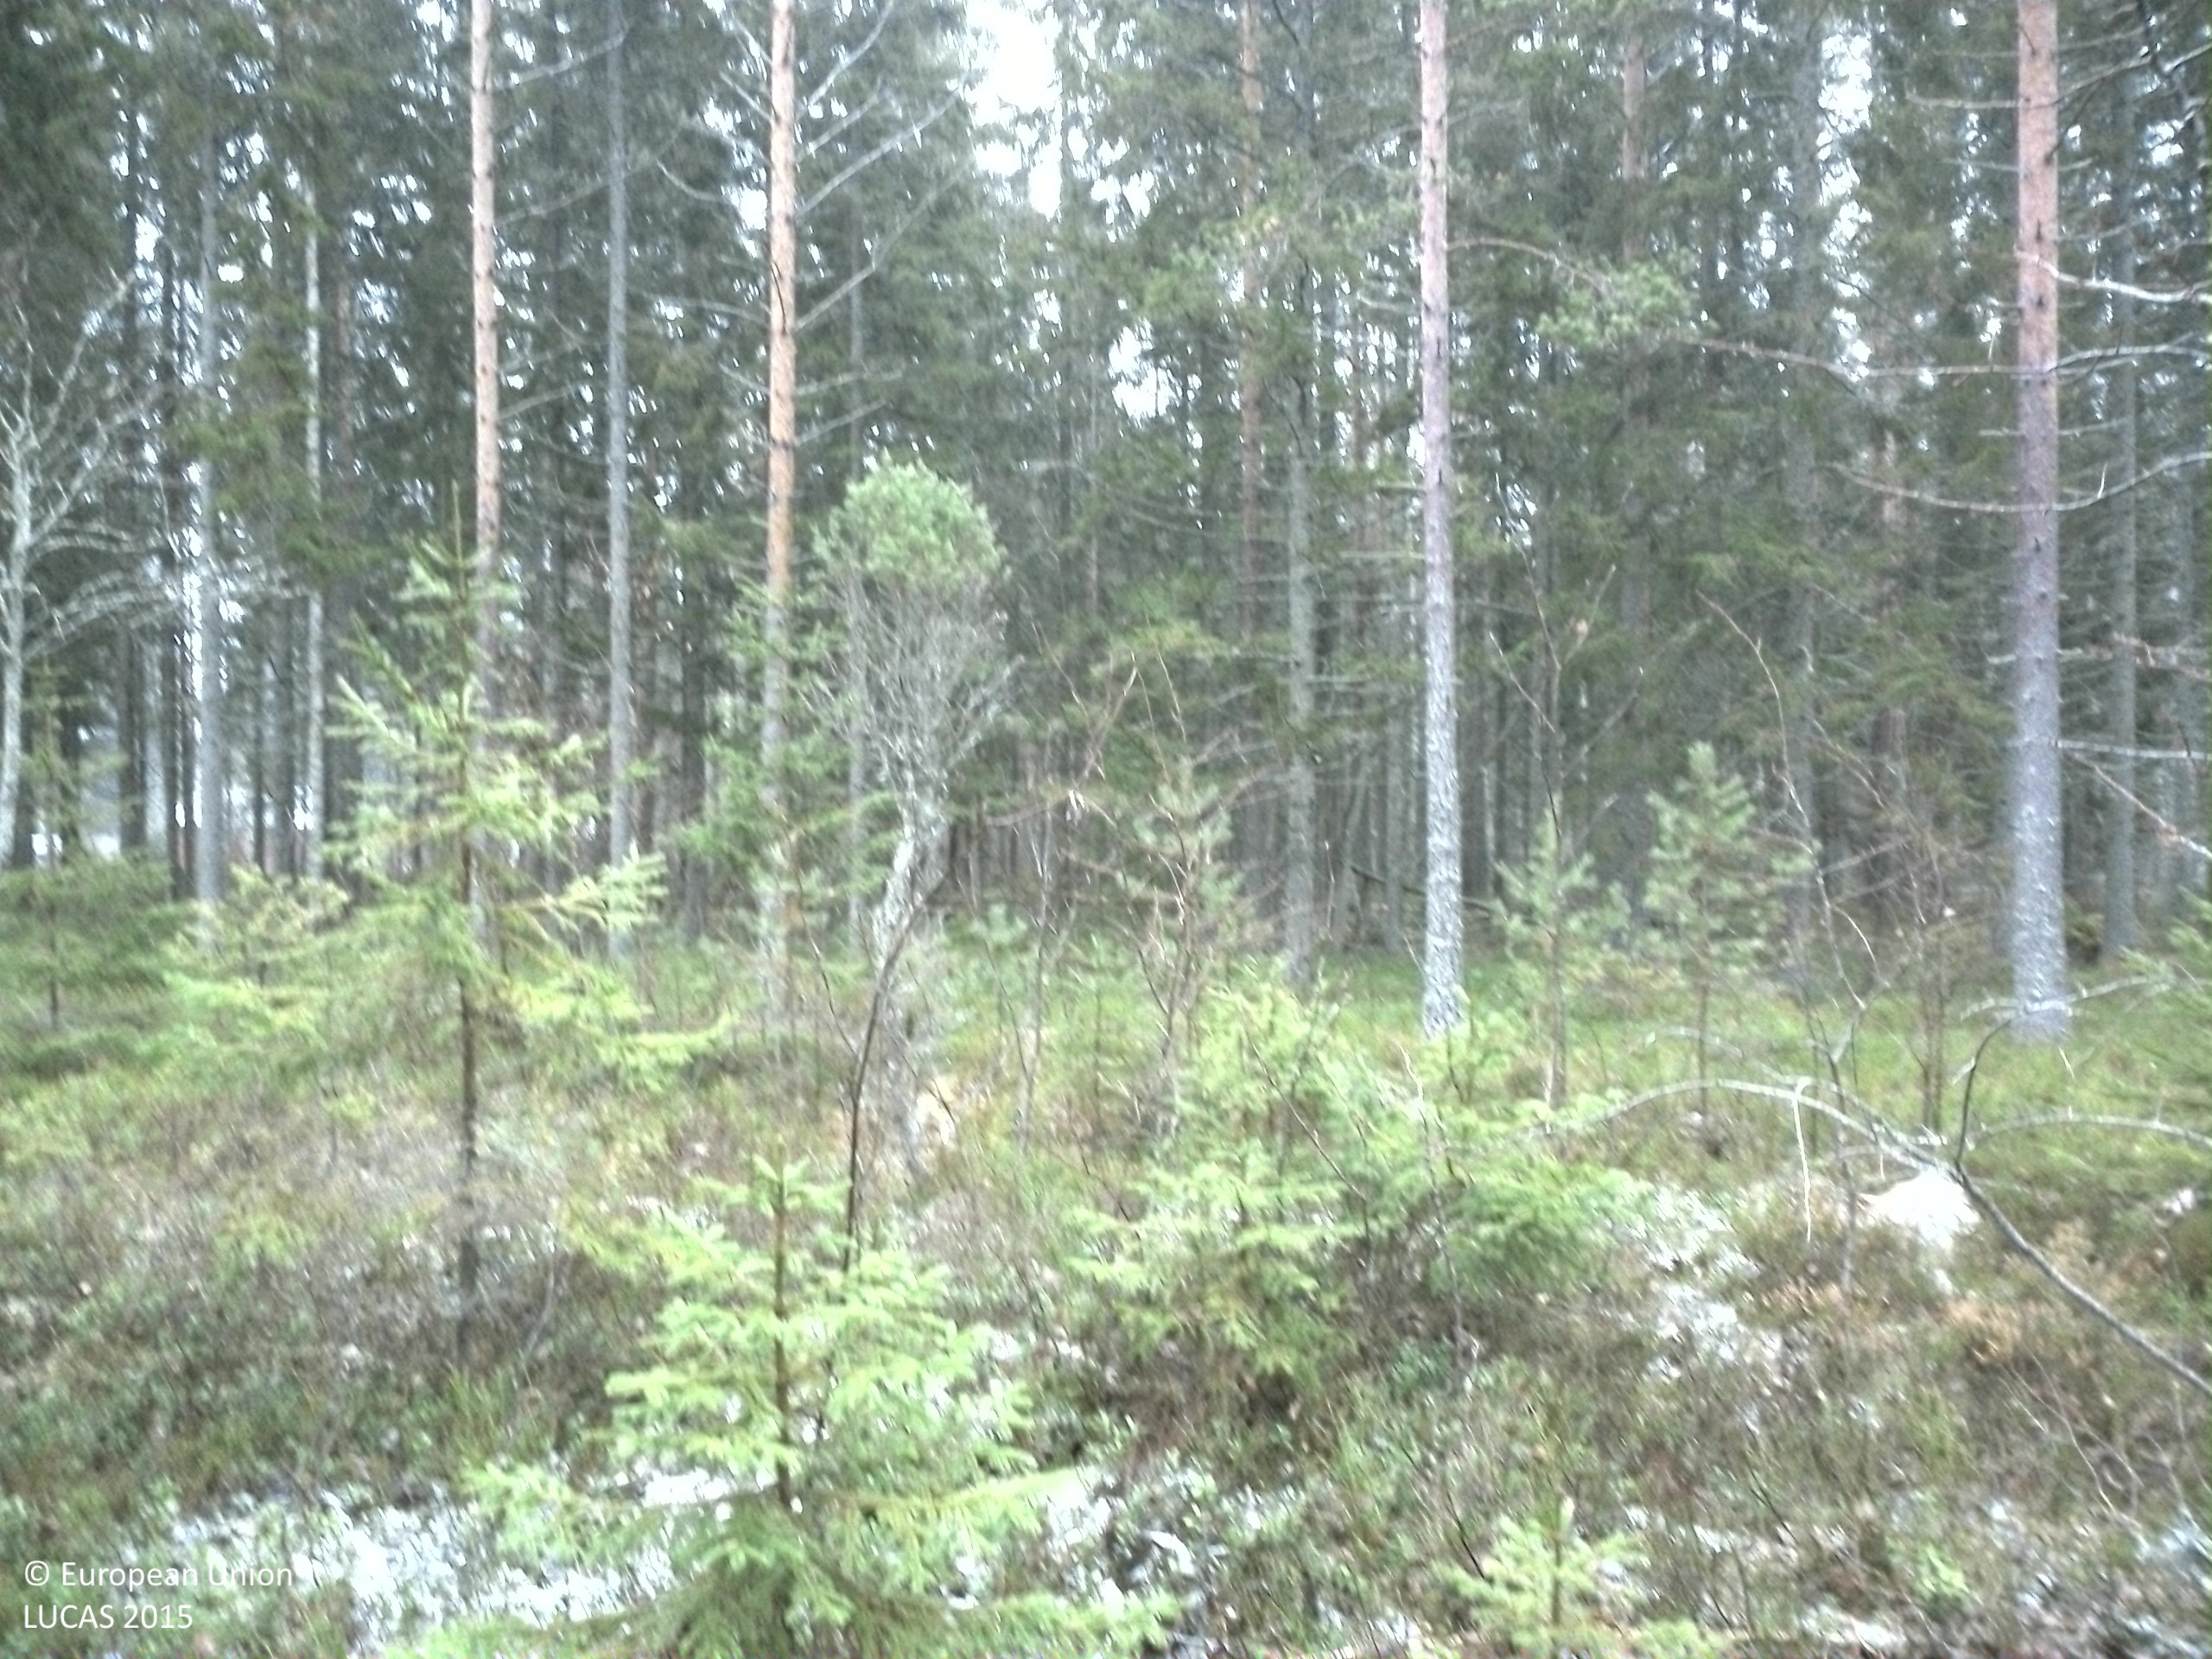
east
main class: Woodland
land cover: Other coniferous woodland
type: boreal forest
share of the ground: 50 - 75 %
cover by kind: coniferous forest trees 60 %, shrubs 25 %, lichens and mosses 10 %, broadleaved forest trees 5 %
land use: Forestry
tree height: > 5 m
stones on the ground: < 10 %
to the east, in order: Other coniferous woodland; Spruce dominated mixed woodland; Other mixed woodland; Spruce dominated mixed woodland; Rivers and streams; Broadleaved woodland
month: November
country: SE
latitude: 60.3513
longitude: 16.6041
